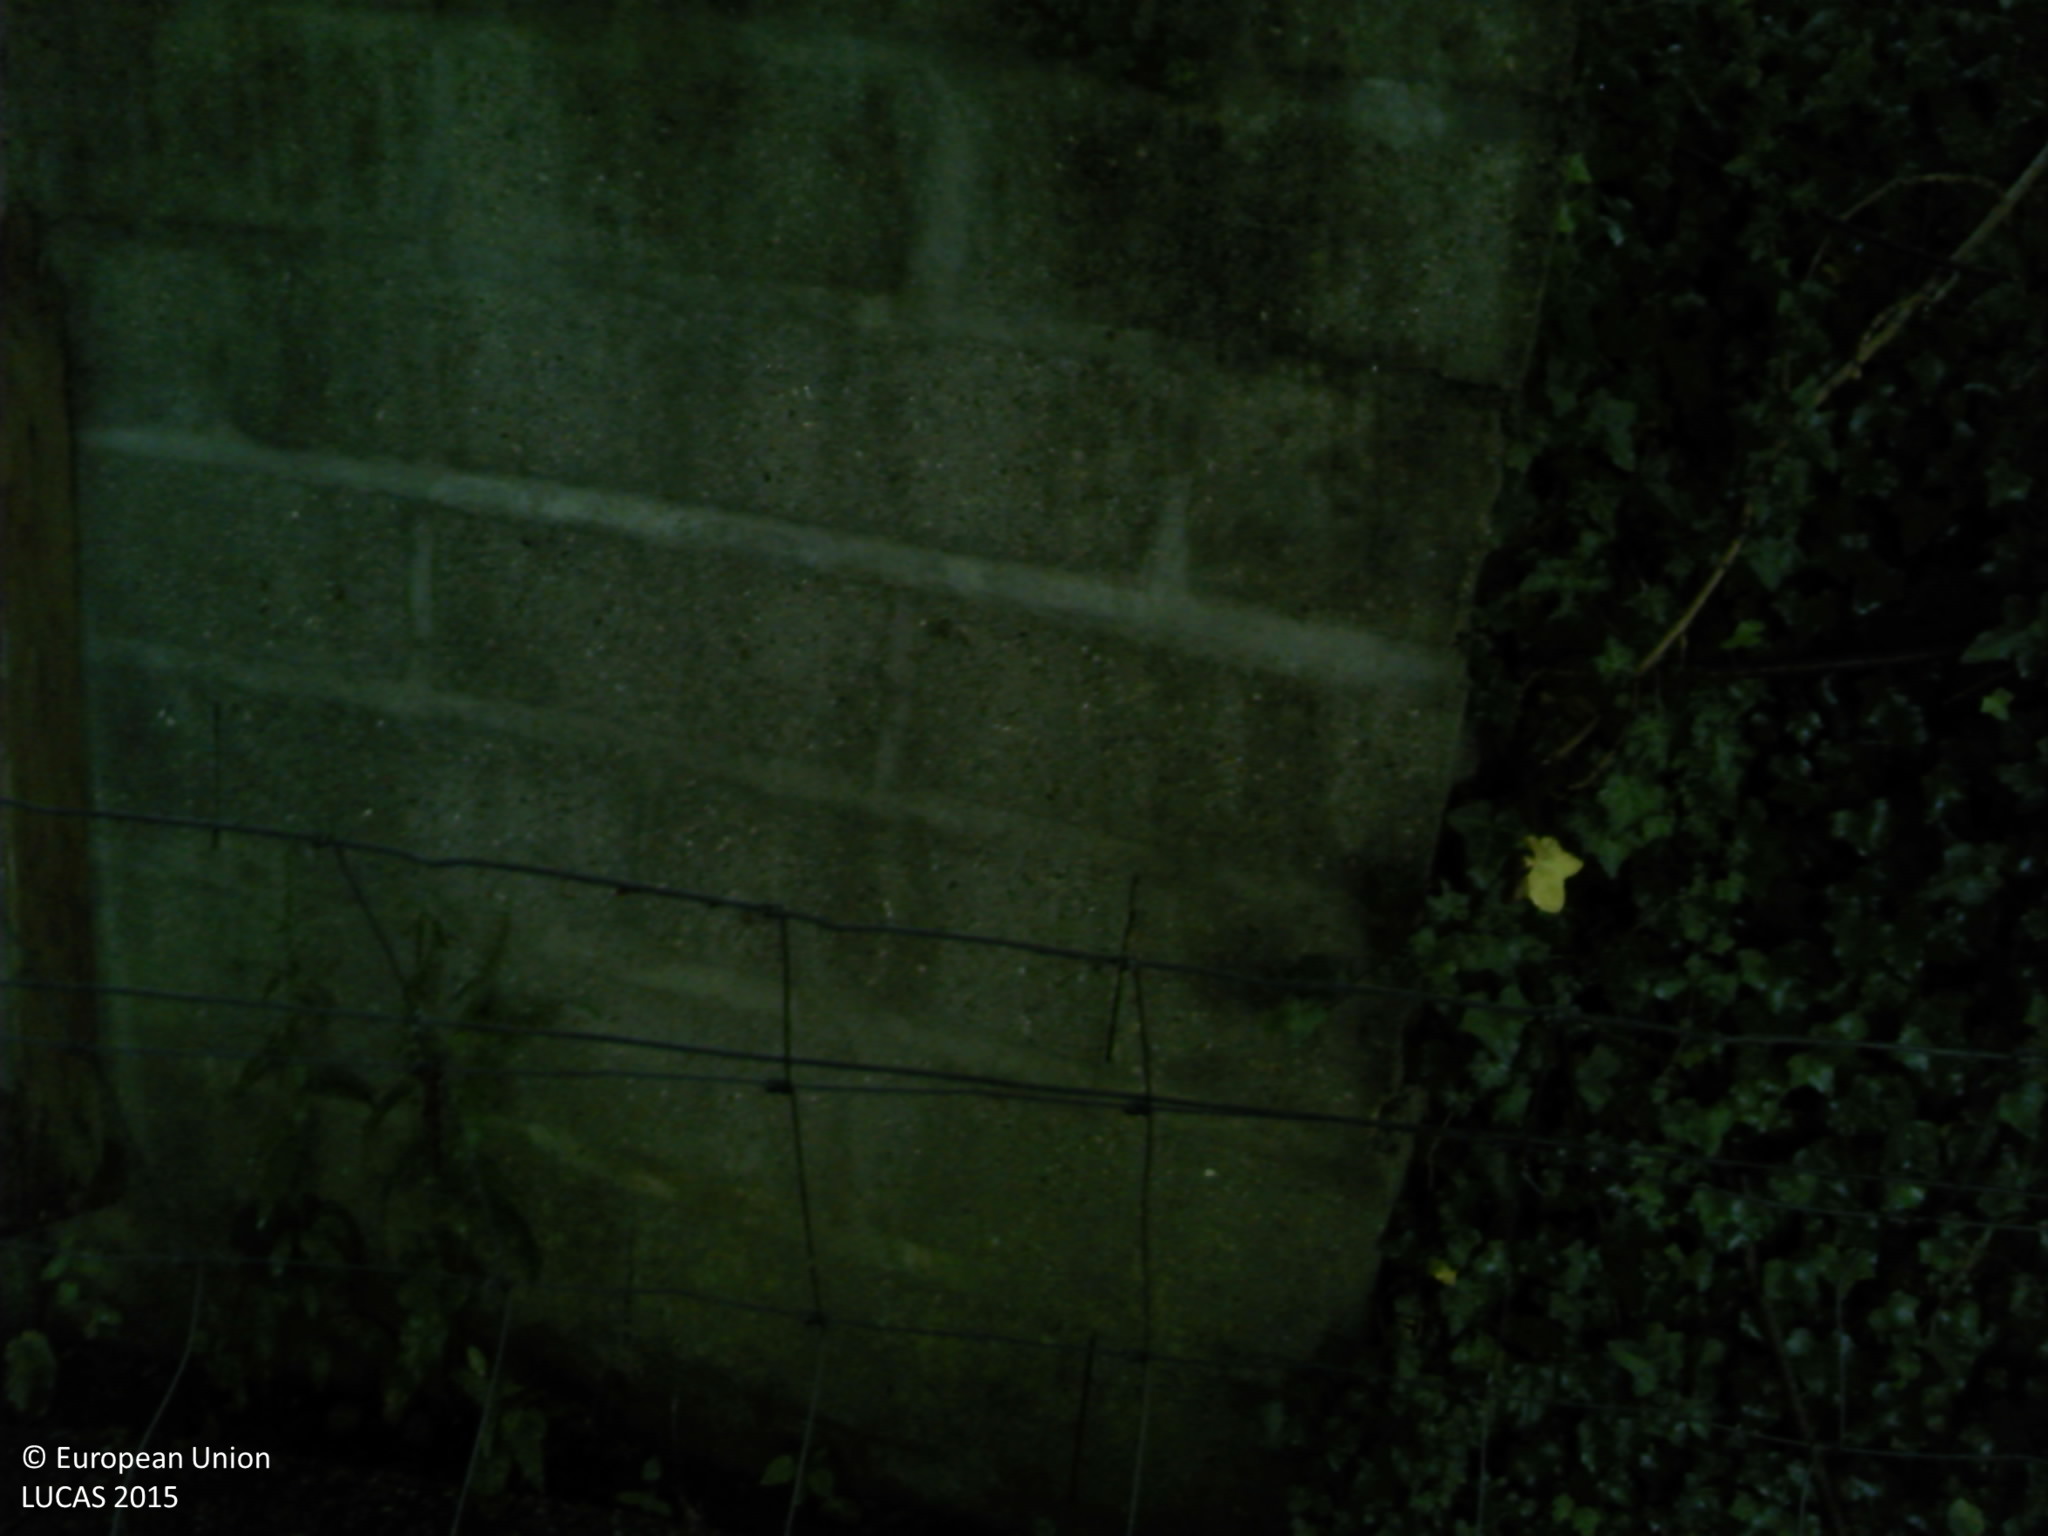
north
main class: Woodland
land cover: Broadleaved woodland
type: mesophytic deciduous forest
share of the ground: > 75 %
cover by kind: broadleaved forest trees 95 %, herbaceous plants 5 %
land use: Residential
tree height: > 5 m
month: June
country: FR
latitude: 49.4974
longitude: 0.2925
